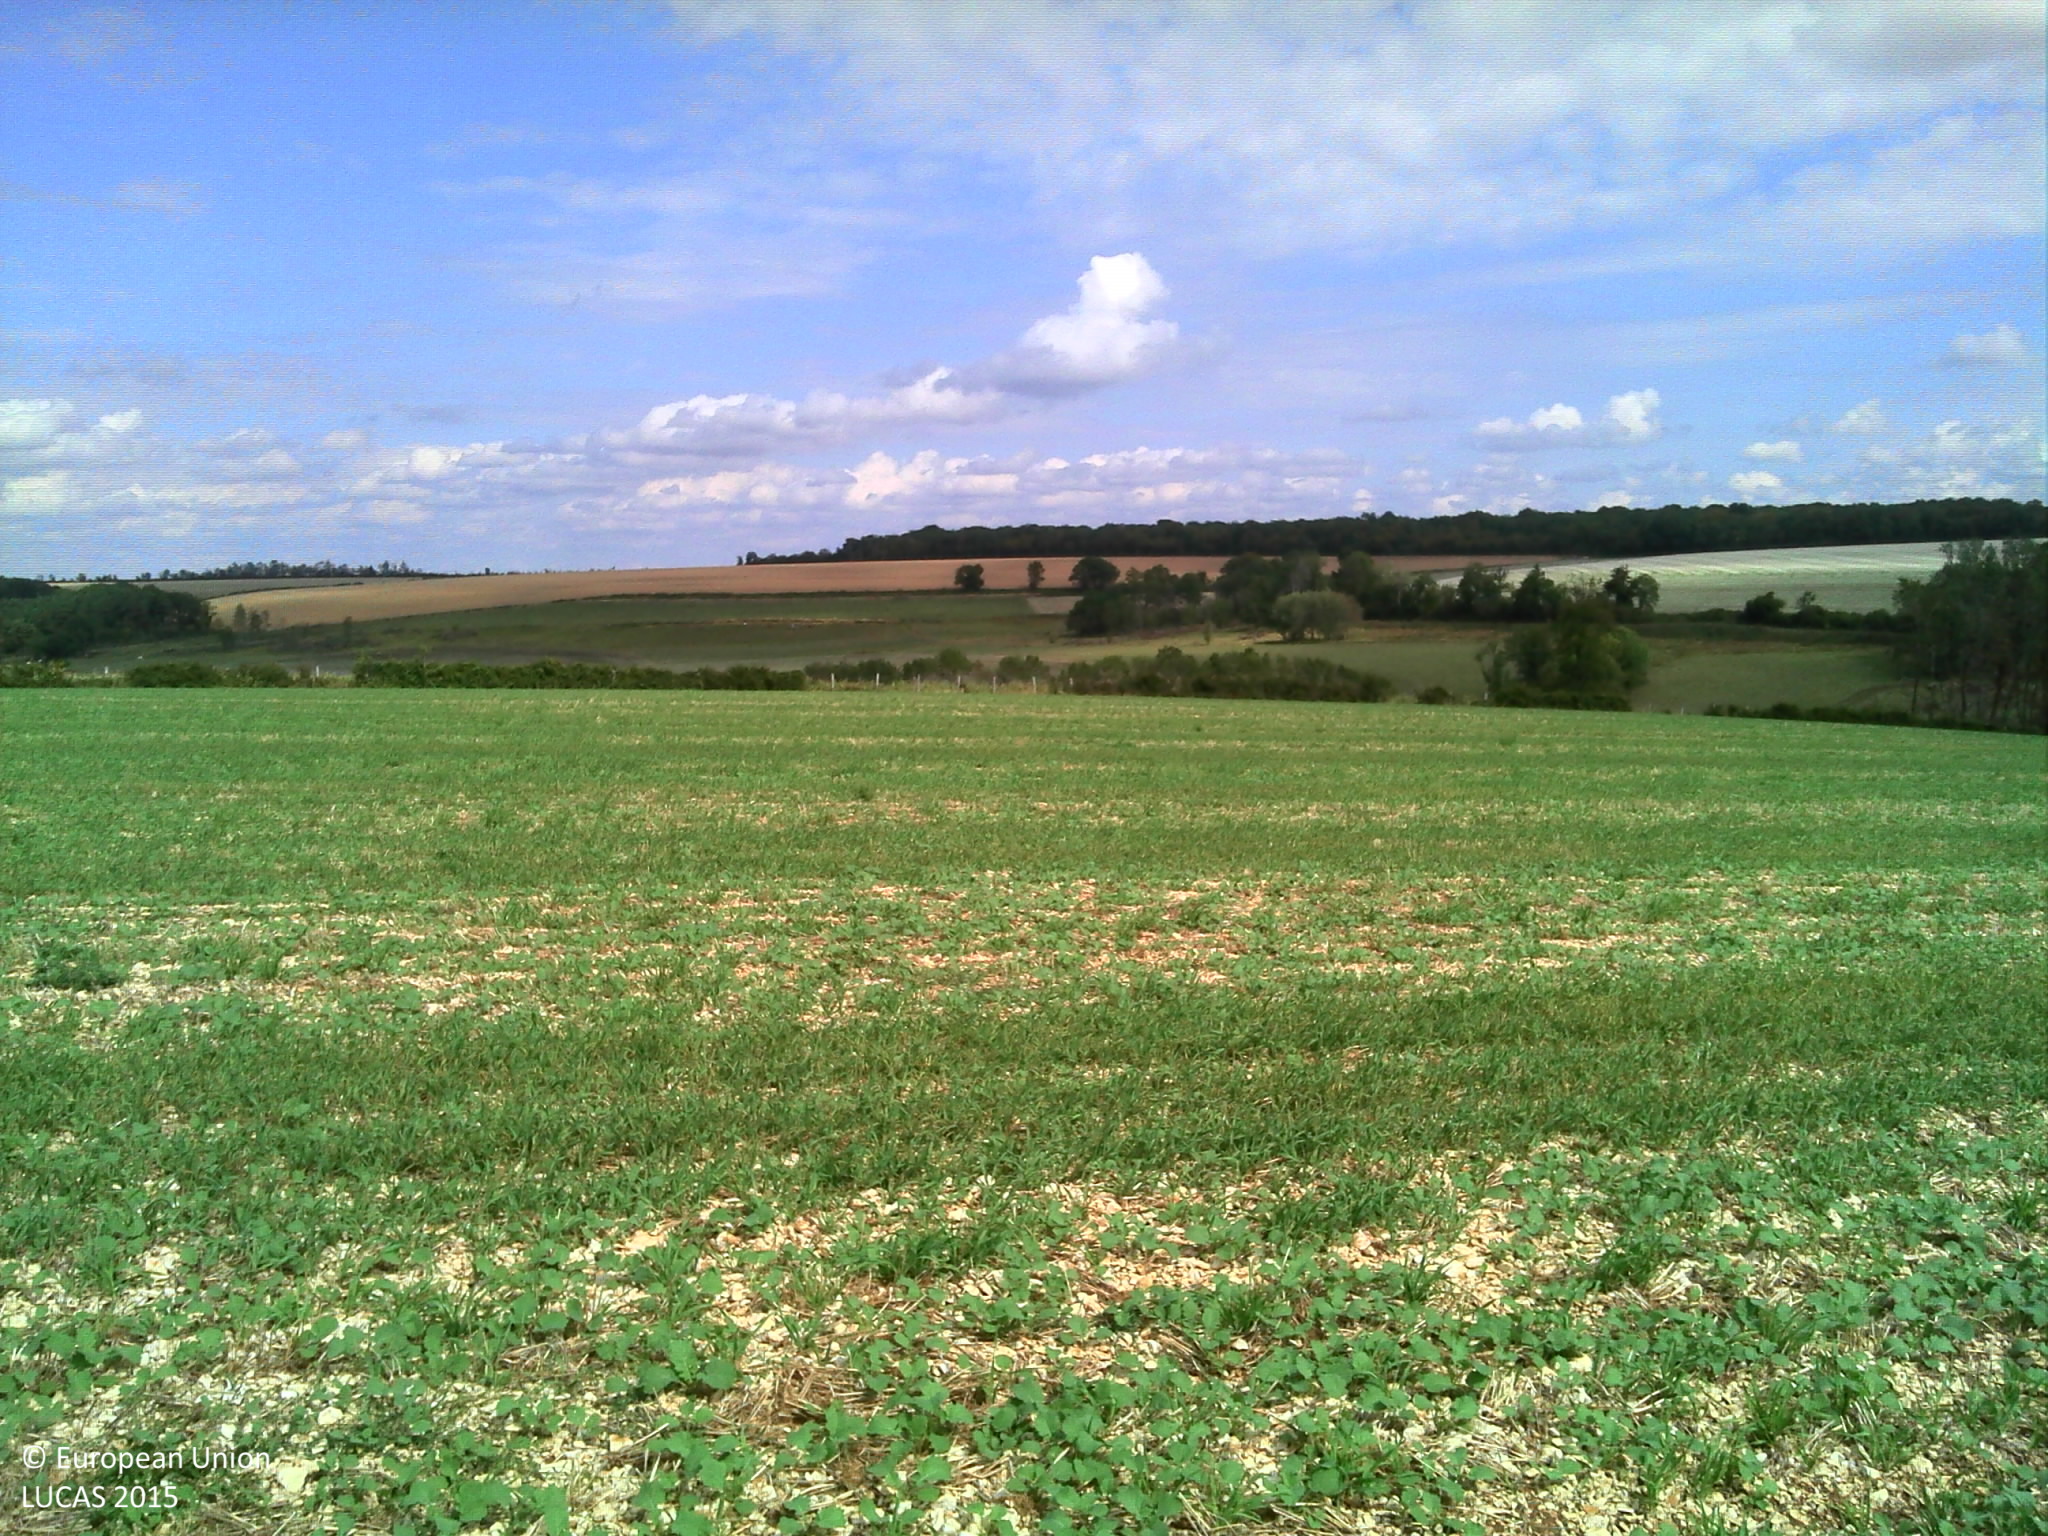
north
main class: Cropland
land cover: Barley
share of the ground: 10 - 25 %
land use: Agriculture (excluding fallow land and kitchen gardens)
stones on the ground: > 50 %
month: September
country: FR
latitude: 47.6368
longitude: 4.9020
